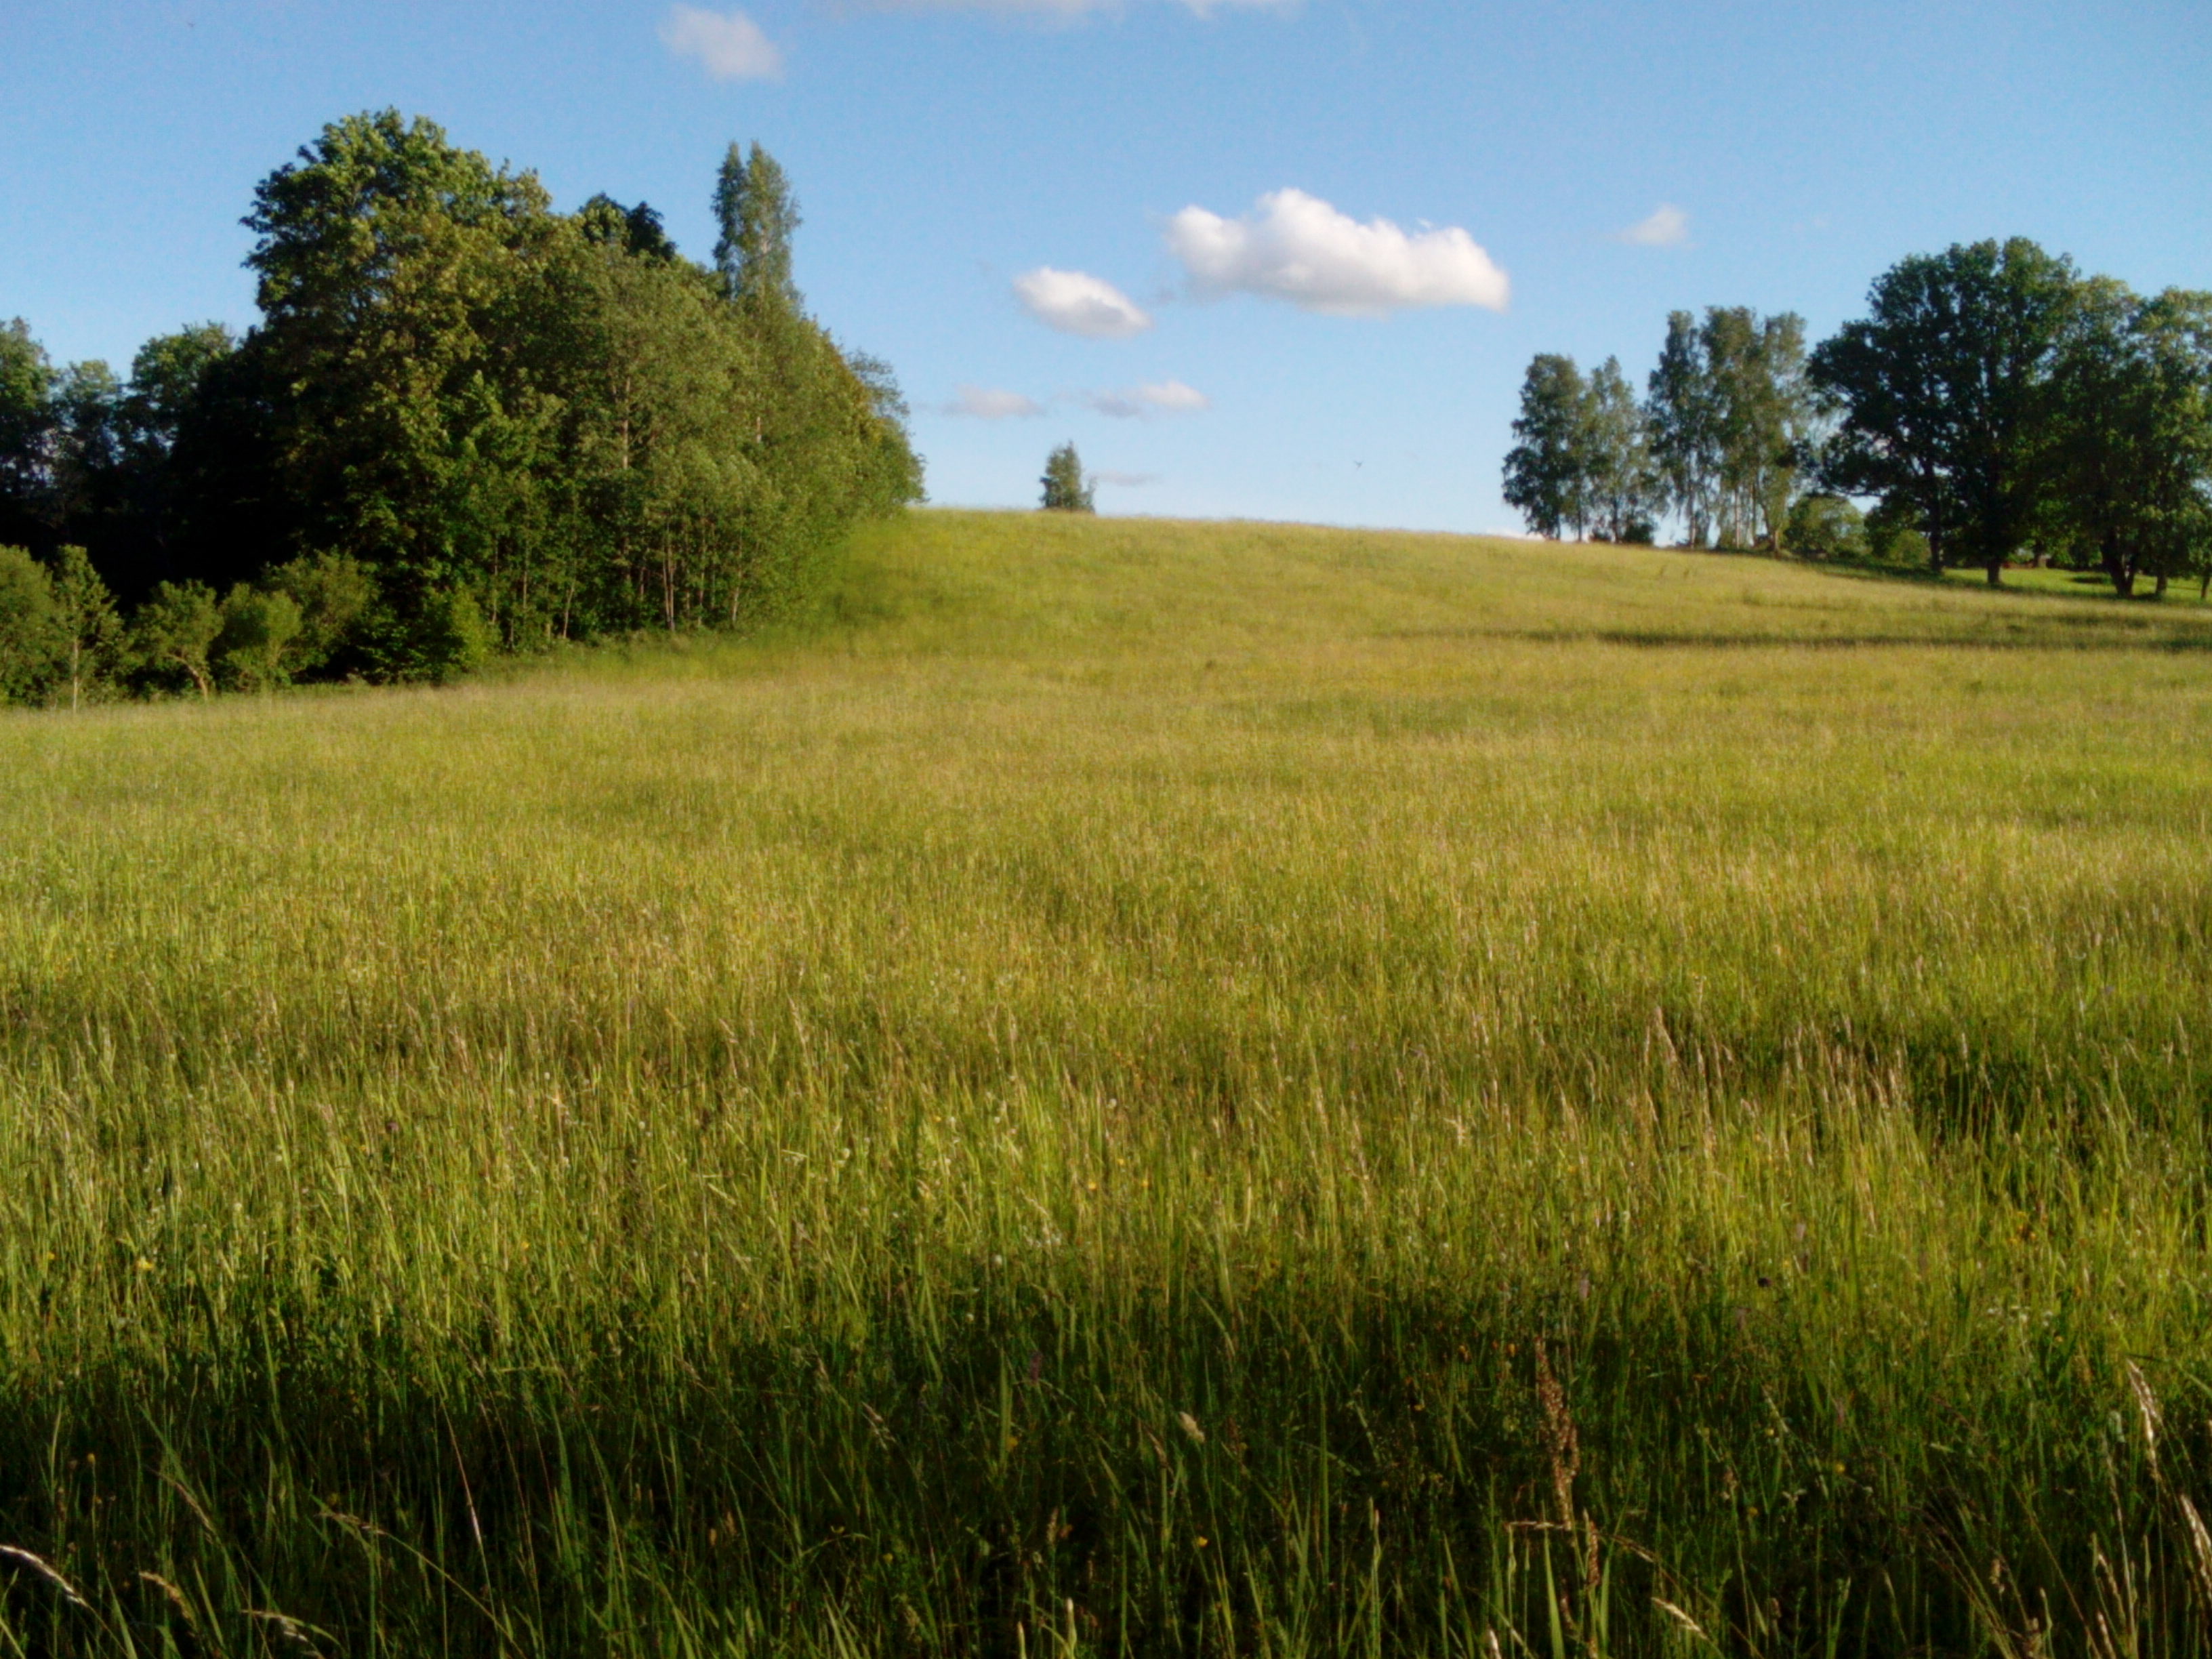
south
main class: Grassland
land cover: Grassland without tree/shrub cover
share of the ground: > 75 %
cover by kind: herbaceous plants 100 %
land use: Agriculture (excluding fallow land and kitchen gardens)
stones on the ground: < 10 %
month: June
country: LV
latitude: 56.6854
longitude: 22.1146
